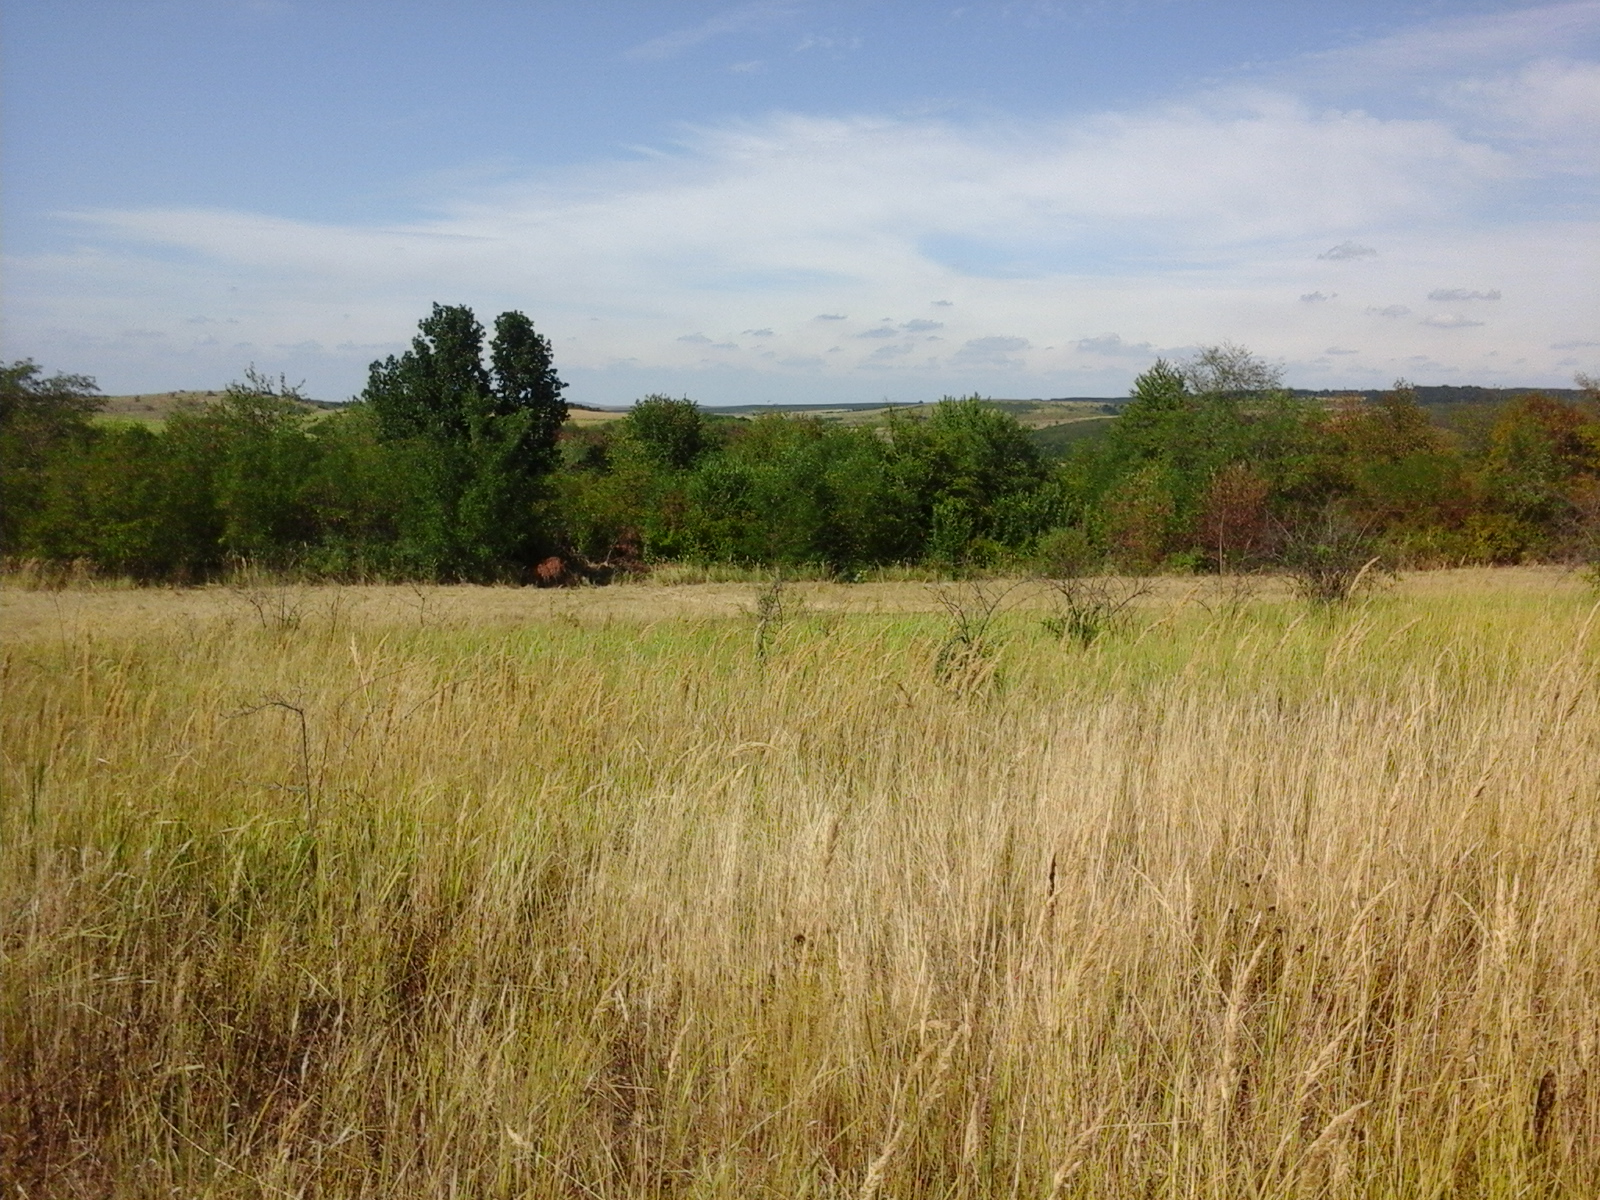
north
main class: Grassland
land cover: Grassland with sparse tree/shrub cover
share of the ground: > 75 %
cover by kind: herbaceous plants 95 %, broadleaved forest trees 5 %
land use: Agriculture (excluding fallow land and kitchen gardens)
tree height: < 5 m
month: August
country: RO
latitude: 45.2039
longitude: 21.4754
